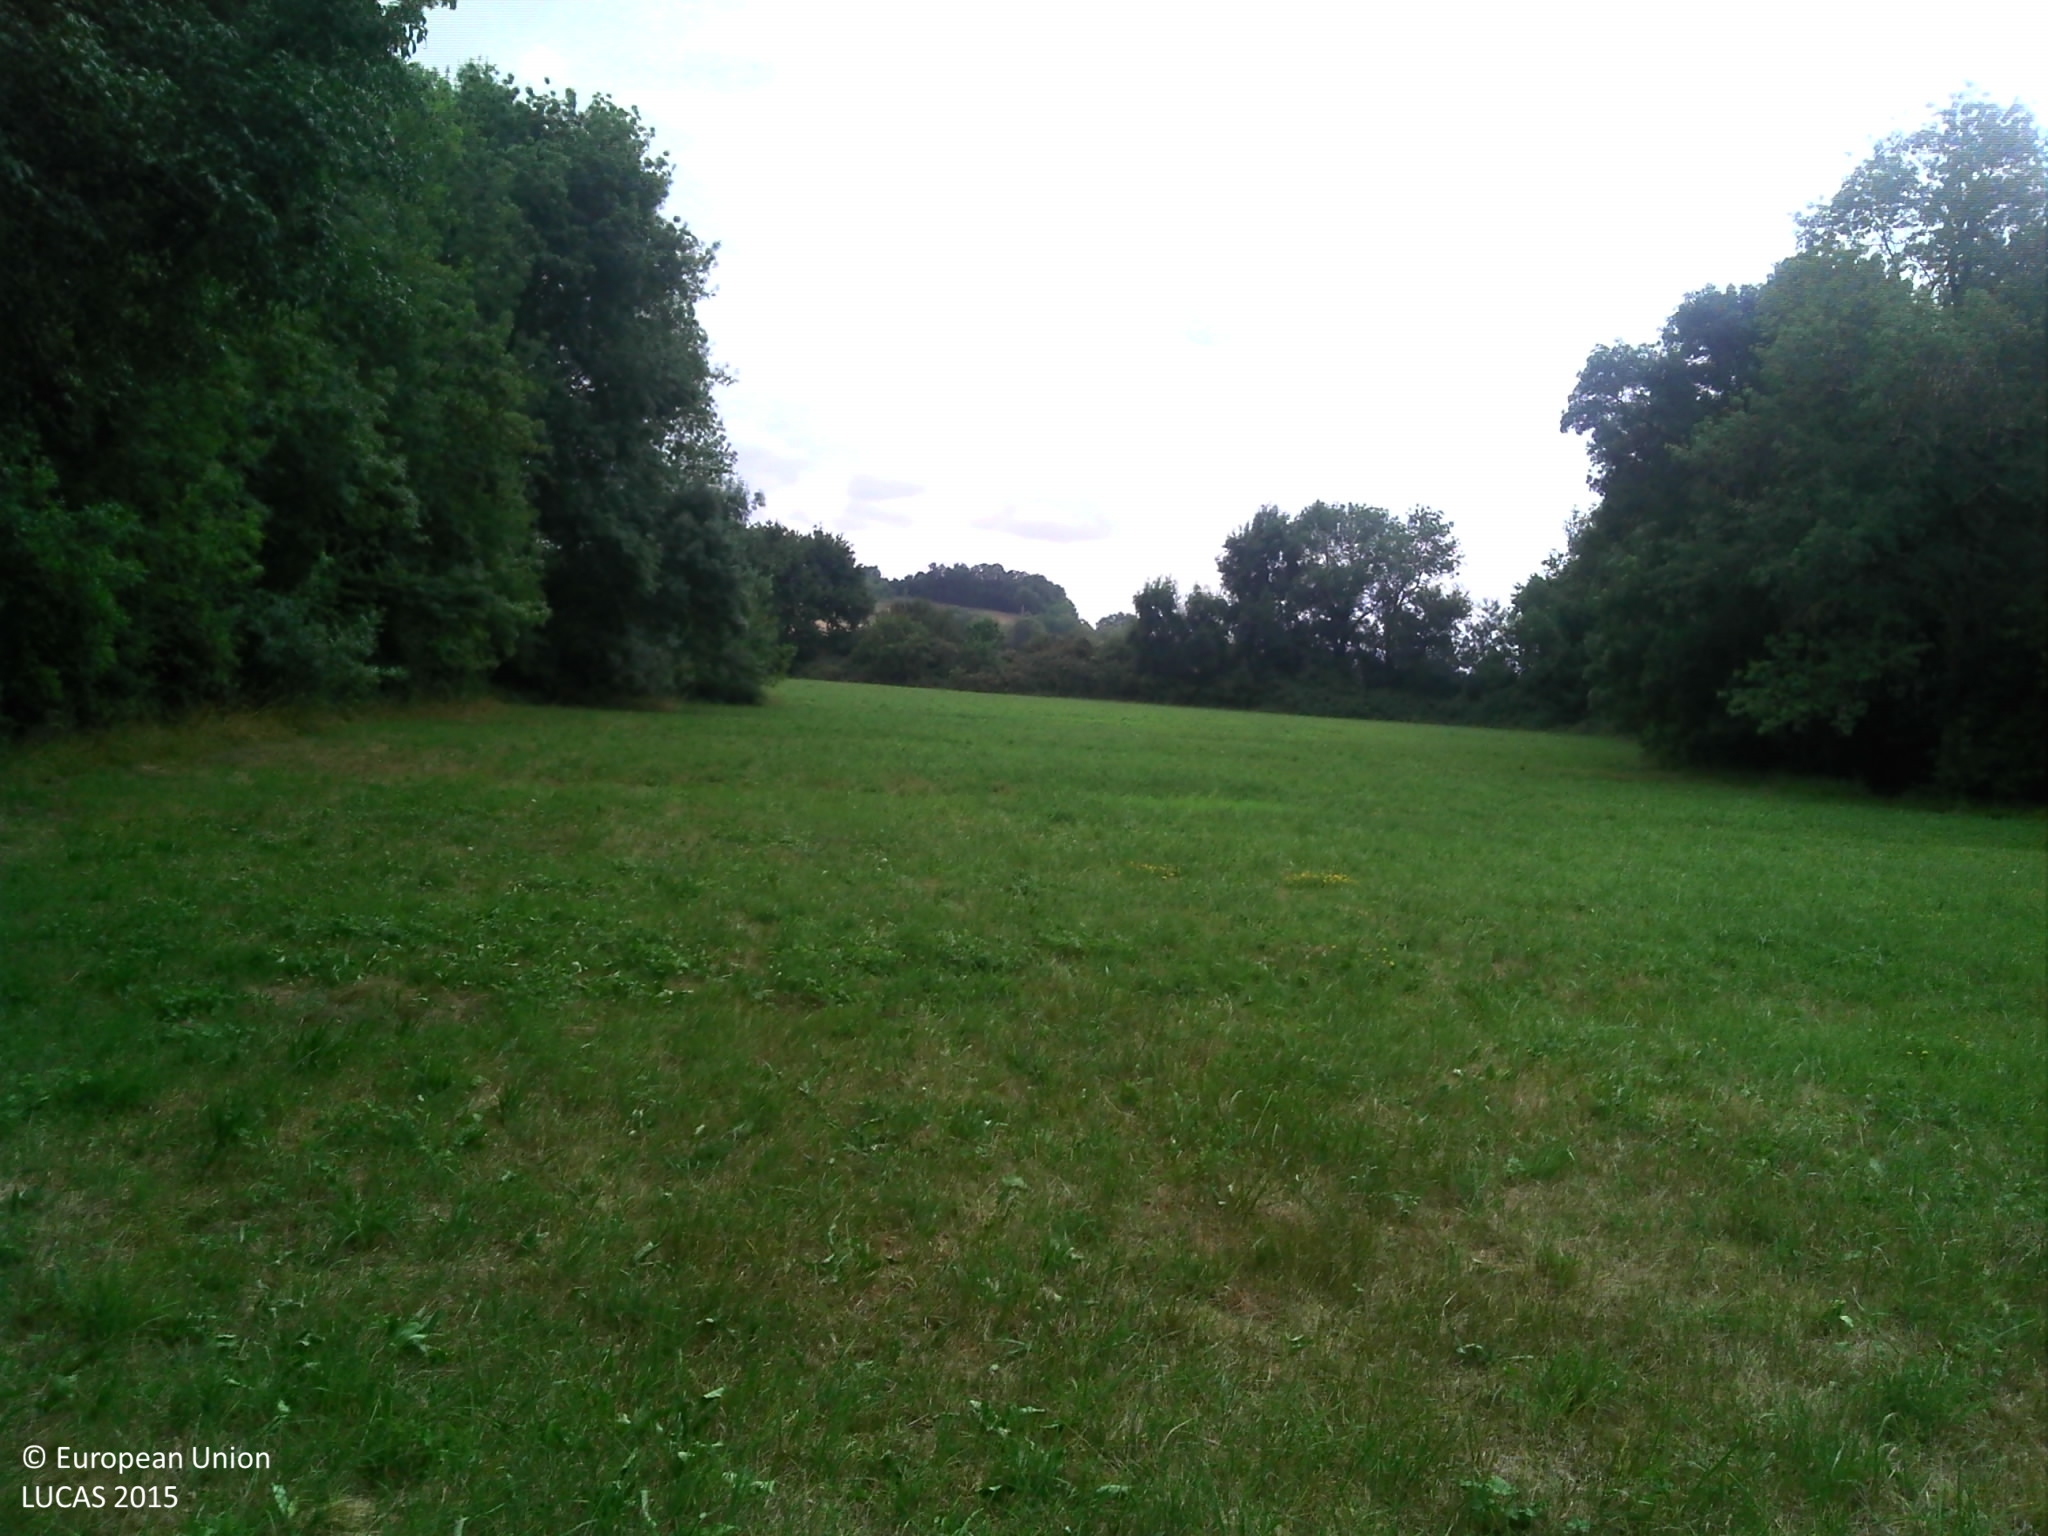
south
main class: Grassland
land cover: Grassland without tree/shrub cover
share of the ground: > 75 %
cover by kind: herbaceous plants 100 %
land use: Agriculture (excluding fallow land and kitchen gardens)
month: July
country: FR
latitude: 43.8059
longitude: 0.9121
